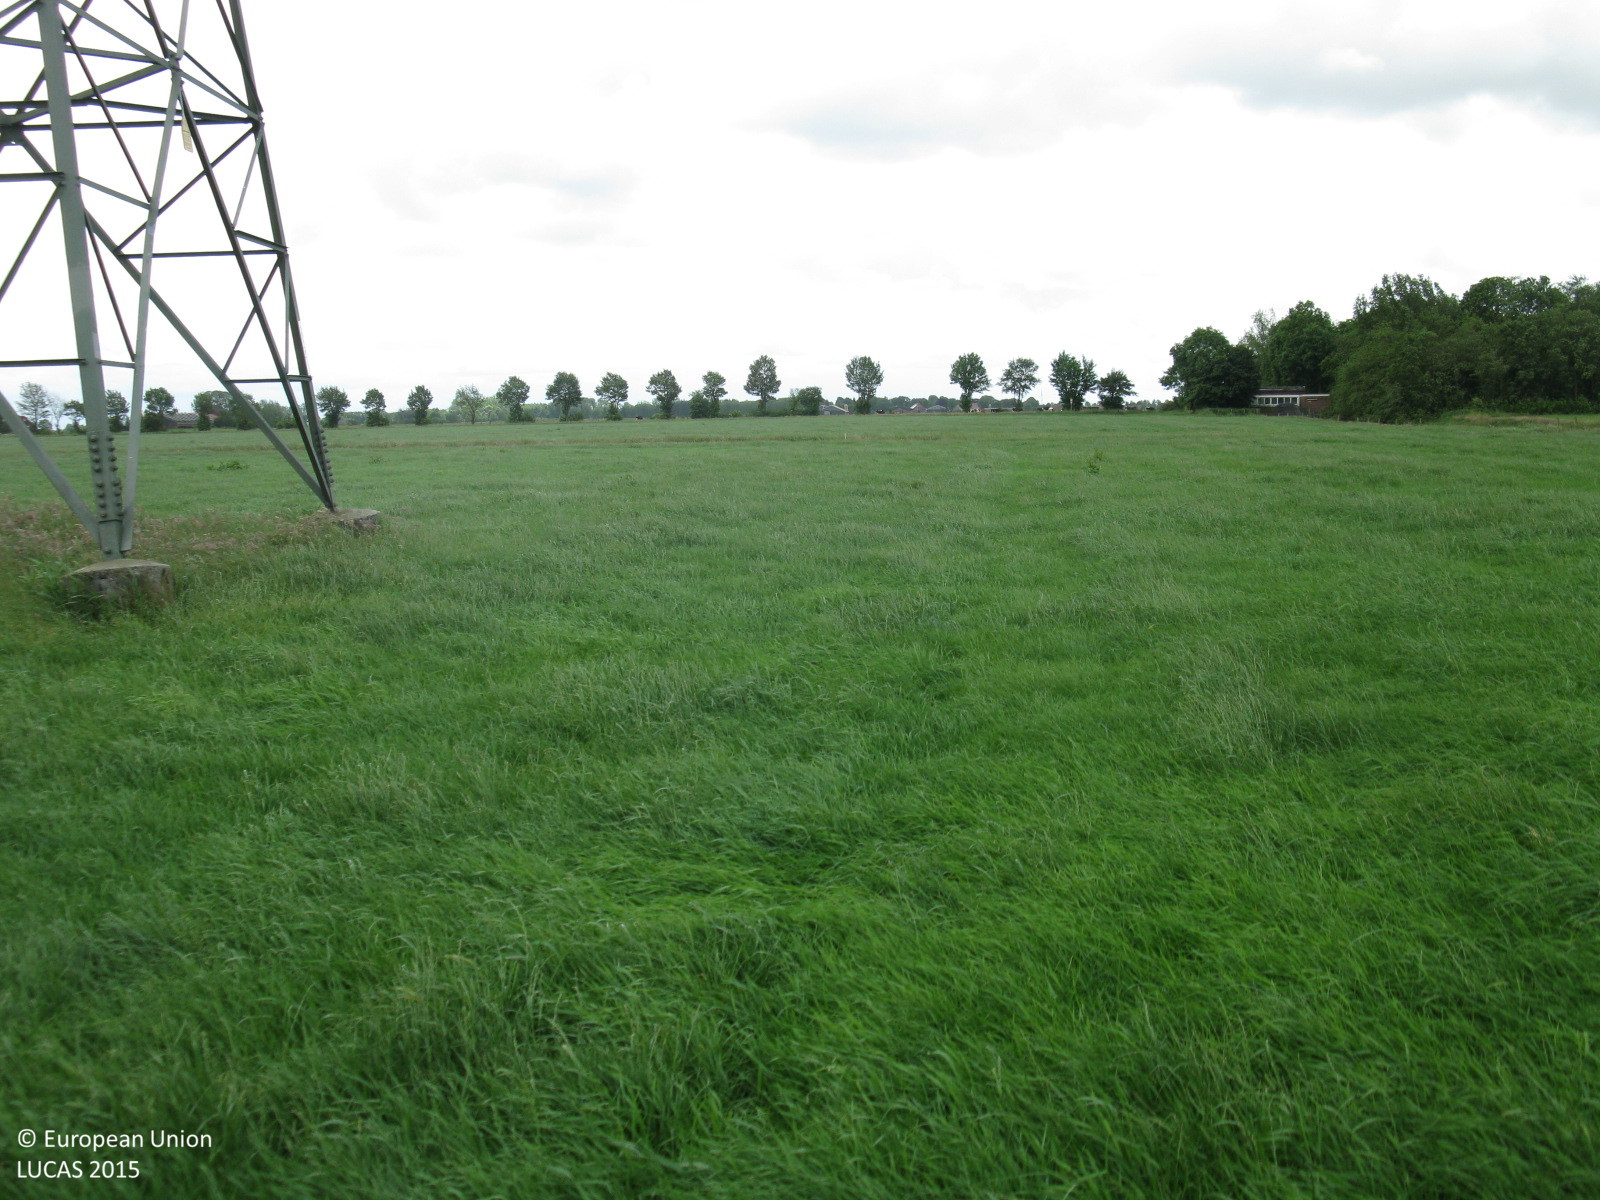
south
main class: Grassland
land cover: Grassland without tree/shrub cover
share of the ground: > 75 %
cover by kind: herbaceous plants 100 %
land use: Agriculture (excluding fallow land and kitchen gardens)
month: June
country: DE
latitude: 53.3554
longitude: 7.3713
